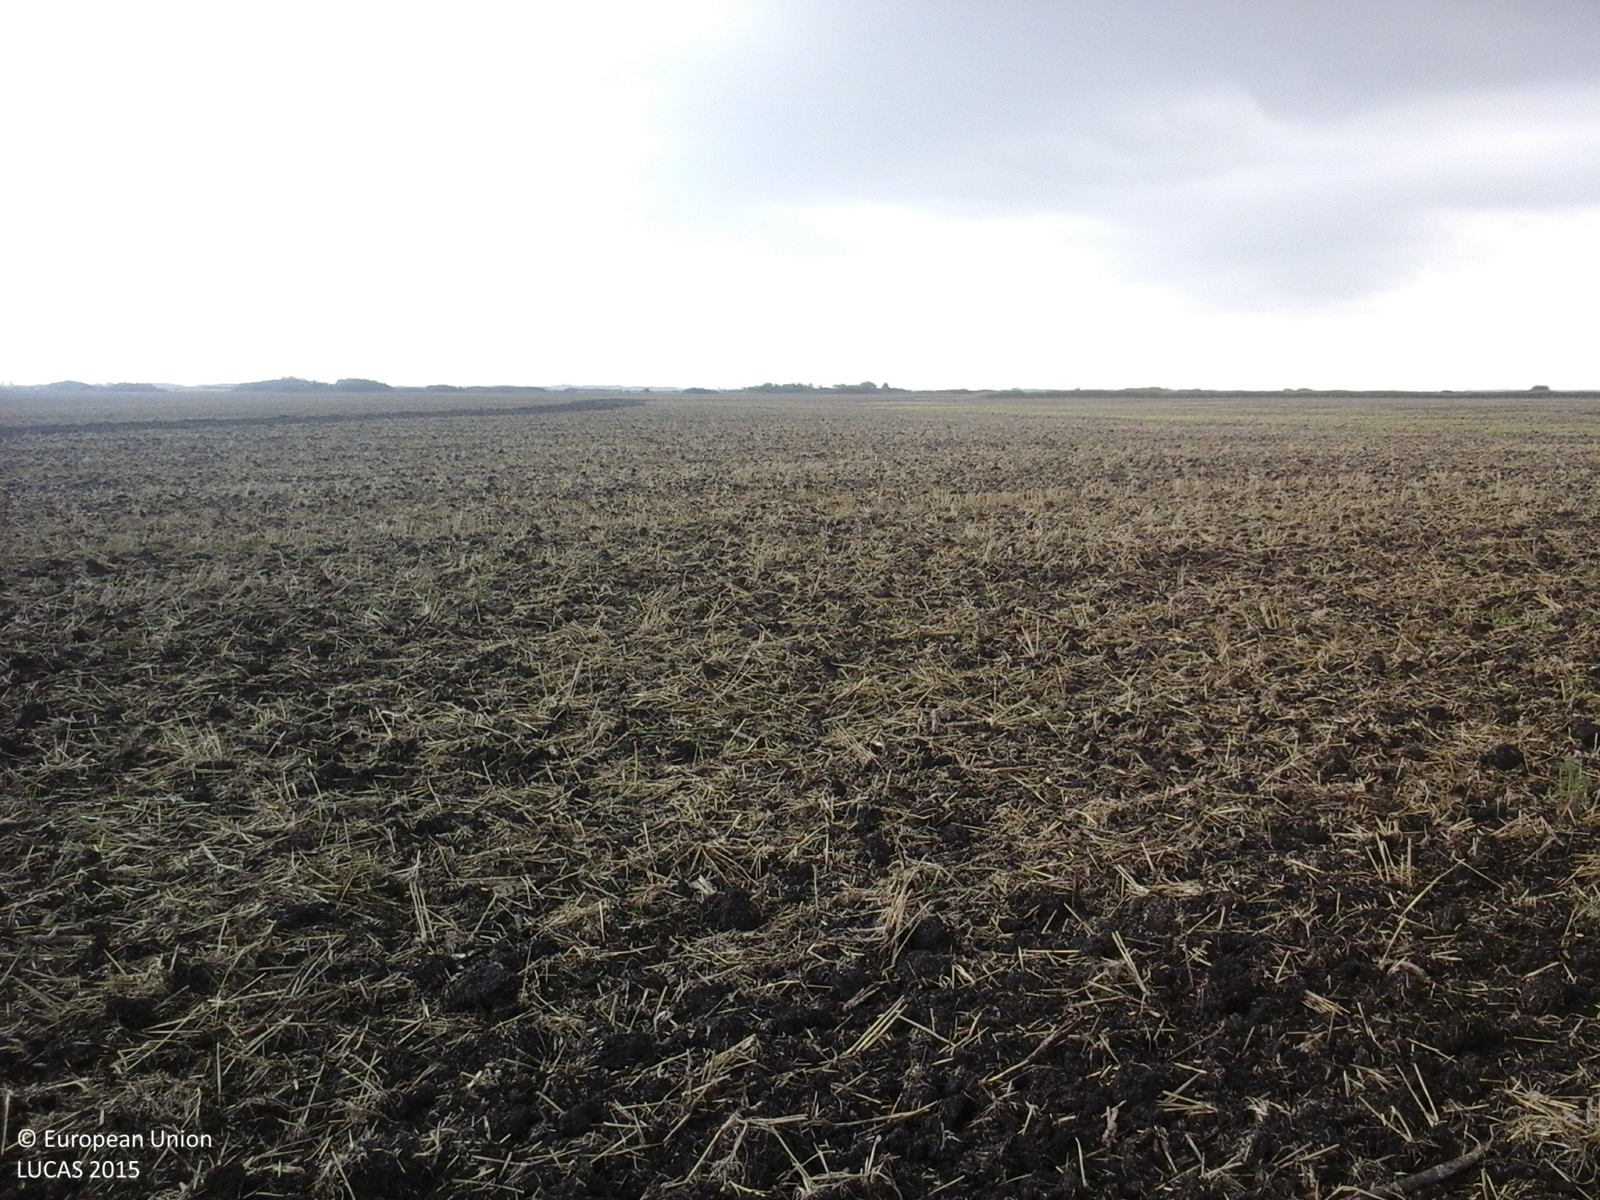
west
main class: Cropland
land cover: Common wheat
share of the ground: < 10 %
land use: Agriculture (excluding fallow land and kitchen gardens)
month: August
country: RO
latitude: 46.0857
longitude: 20.3300
